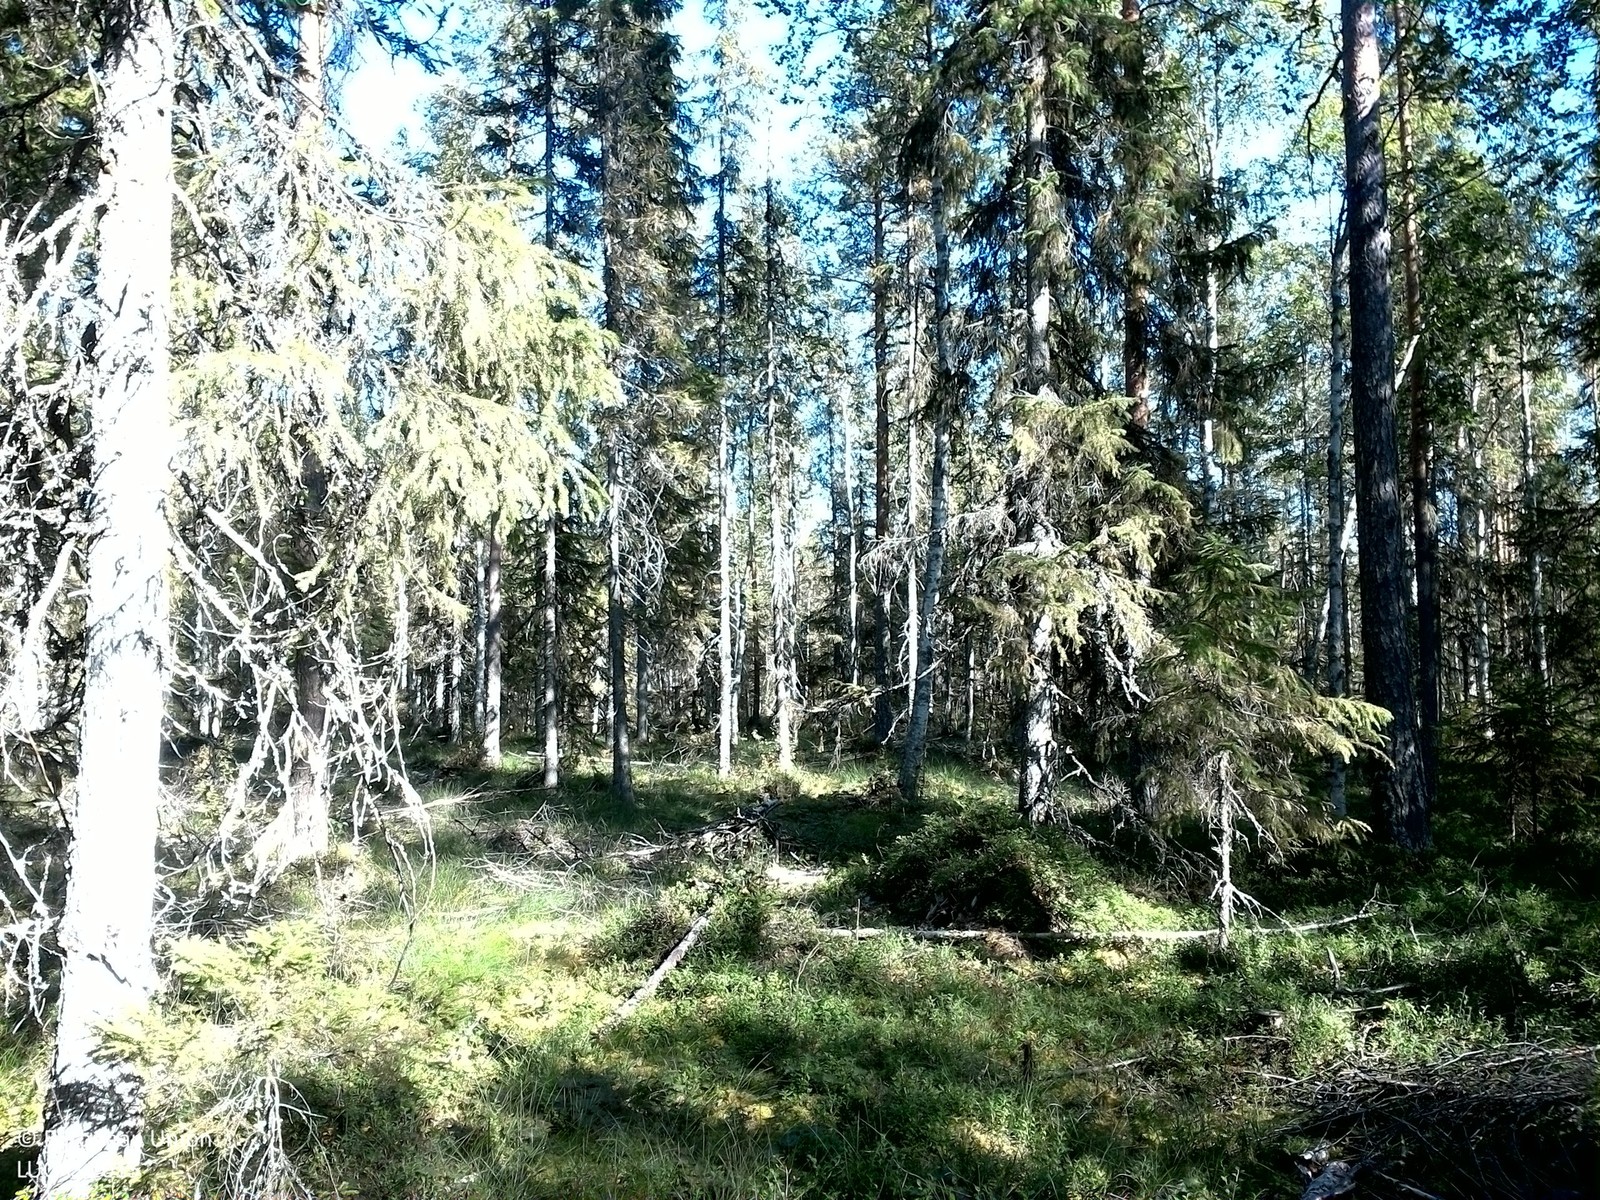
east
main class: Woodland
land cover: Pine dominated mixed woodland
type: boreal forest
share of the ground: 50 - 75 %
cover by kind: coniferous forest trees 40 %, broadleaved forest trees 25 %, lichens and mosses 20 %, herbaceous plants 10 %, shrubs 5 %
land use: Forestry
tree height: > 5 m
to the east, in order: Pine dominated mixed woodland; Pine dominated coniferous woodland; Spruce dominated mixed woodland; Ditches and canals; Pine dominated coniferous woodland; Grass margins; Spruce dominated mixed woodland
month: August
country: SE
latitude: 63.6816
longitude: 17.3921
